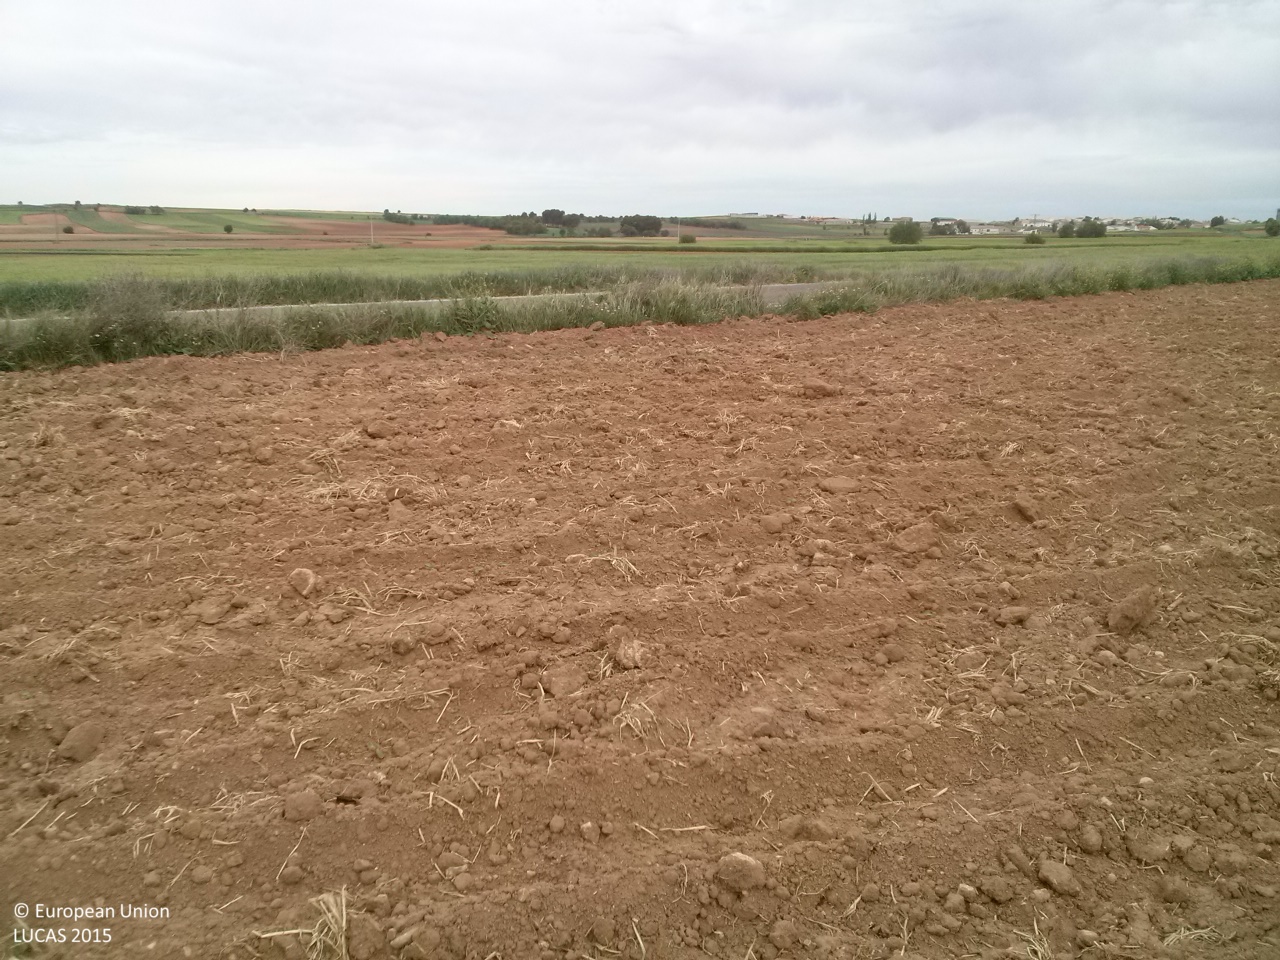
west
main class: Cropland
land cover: Sunflower
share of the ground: < 10 %
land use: Agriculture (excluding fallow land and kitchen gardens)
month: May
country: ES
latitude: 39.9089
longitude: -2.8769
